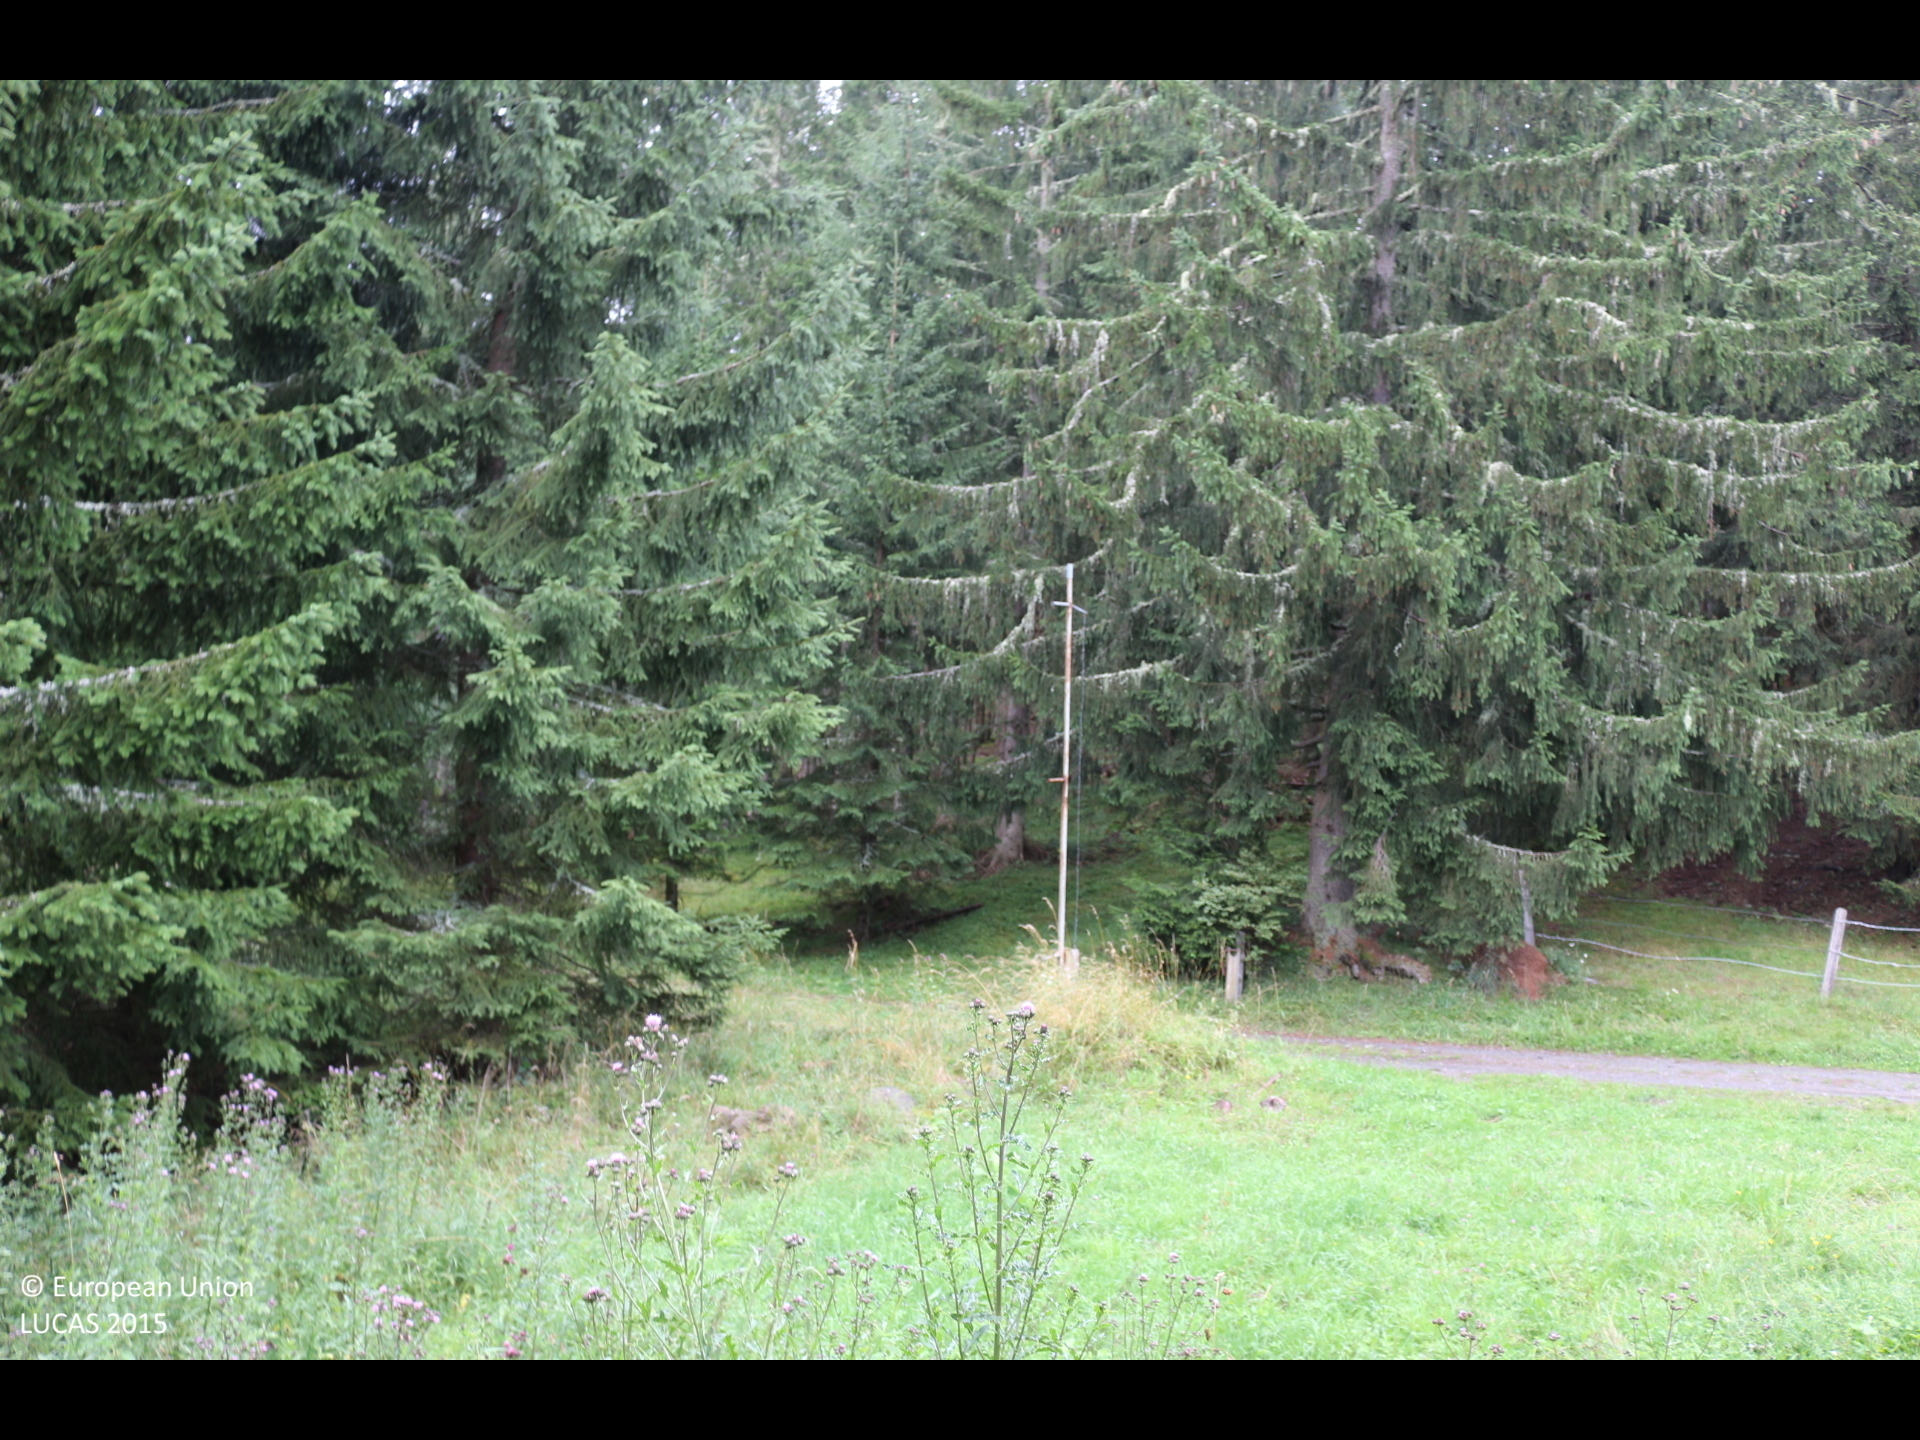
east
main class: Grassland
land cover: Spontaneously vegetated surfaces
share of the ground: > 75 %
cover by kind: herbaceous plants 95 %, shrubs 5 %
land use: Semi-natural and natural areas not in use
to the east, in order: Spontaneously vegetated surfaces; Spruce dominated coniferous woodland; Spontaneously vegetated surfaces; Tracks; Spruce dominated coniferous woodland; Tracks; Spruce dominated coniferous woodland
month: July
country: AT
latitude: 46.9703
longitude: 14.2435
